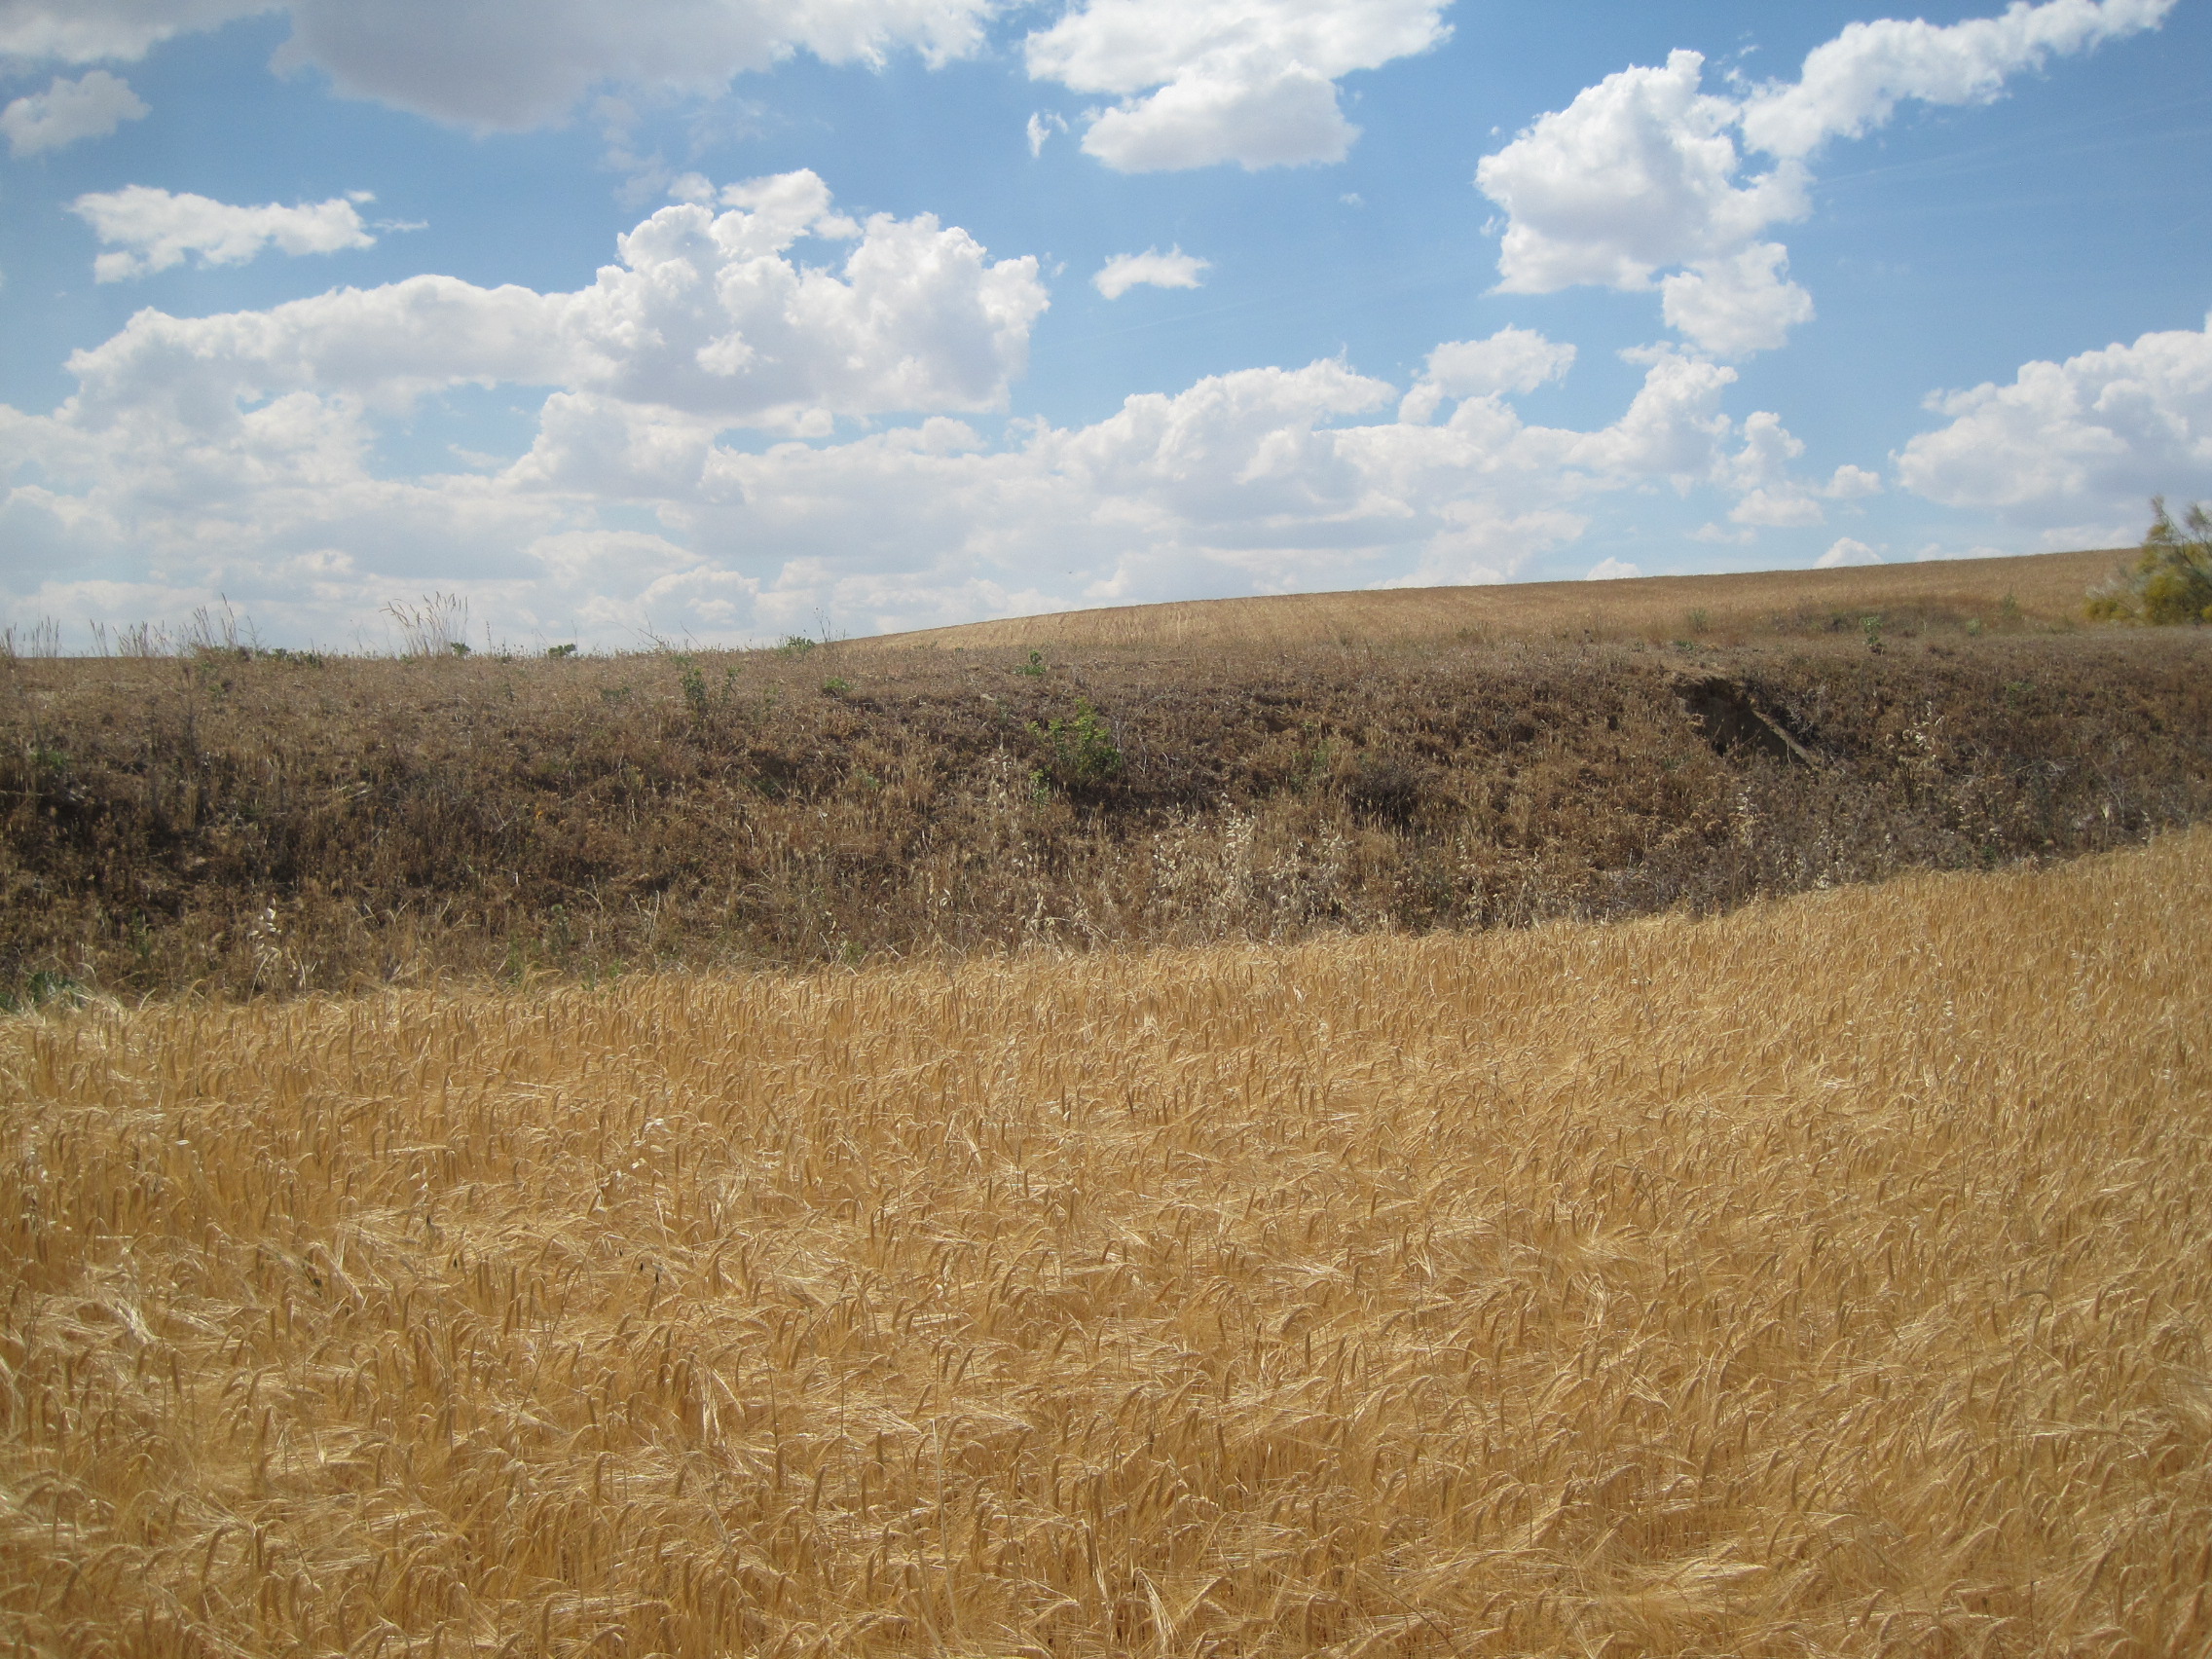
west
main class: Cropland
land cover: Barley
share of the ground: > 75 %
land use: Agriculture (excluding fallow land and kitchen gardens)
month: June
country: ES
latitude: 41.3601
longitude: -5.2684
